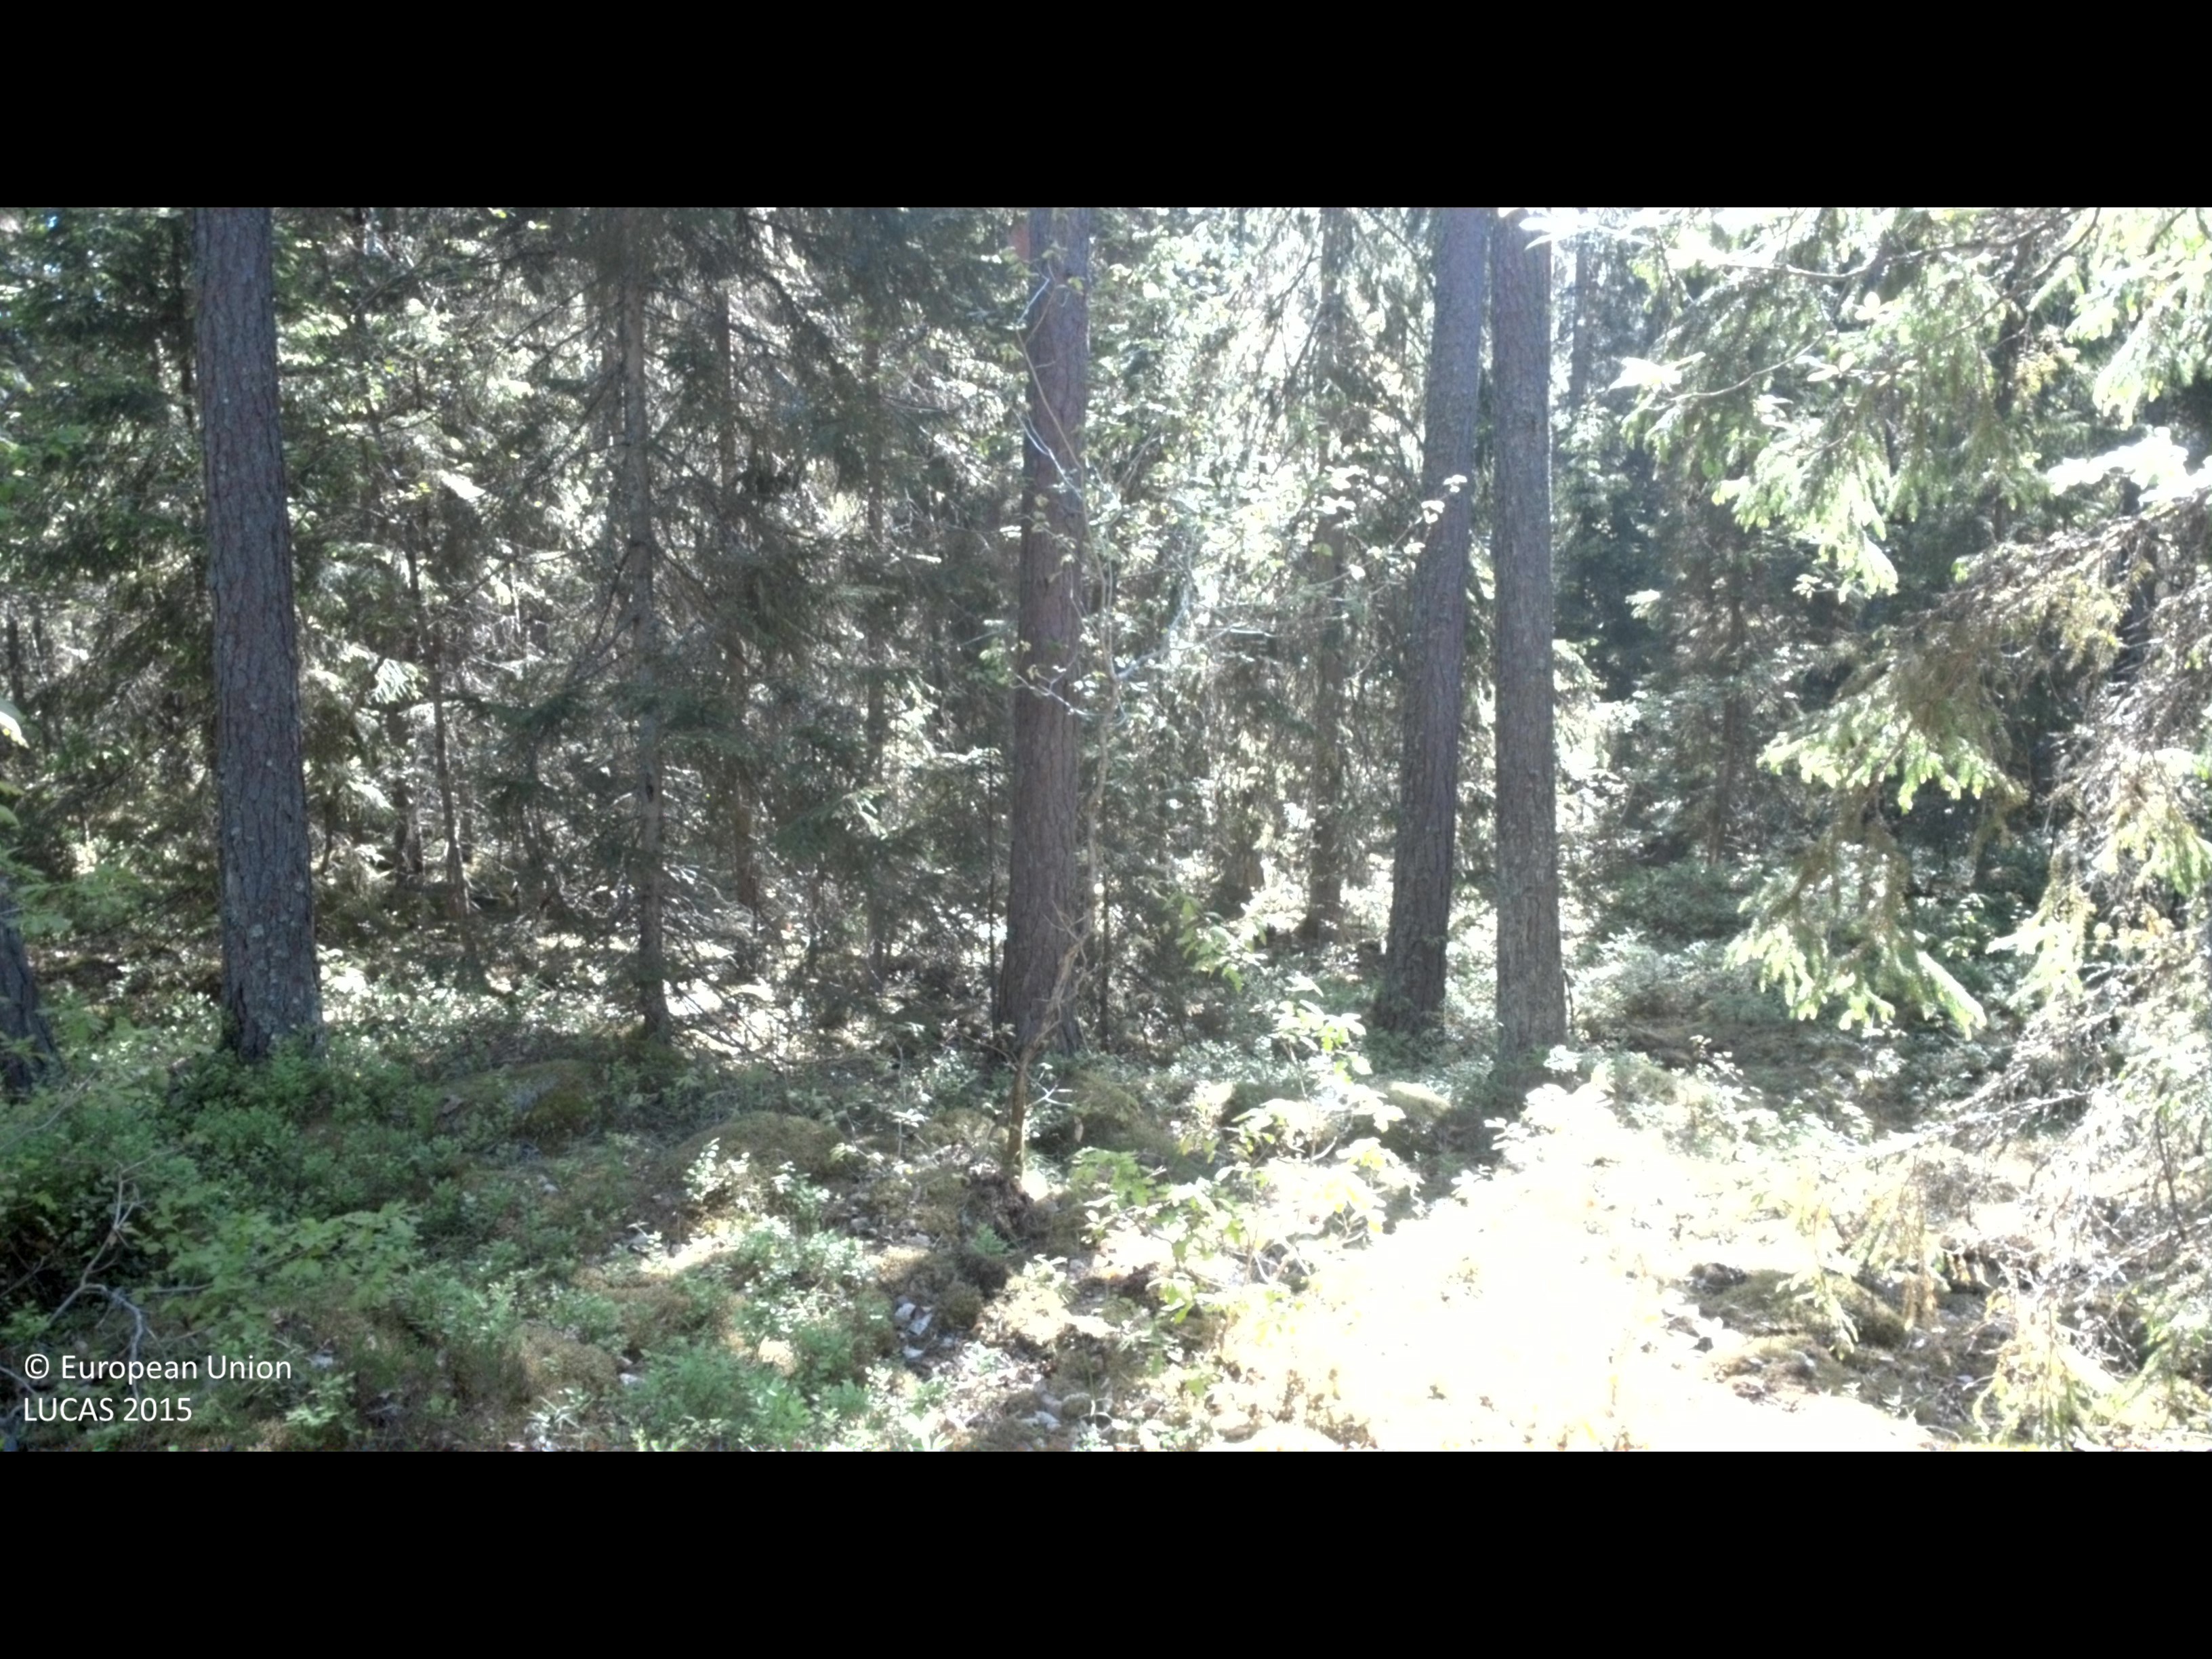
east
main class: Woodland
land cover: Pine dominated coniferous woodland
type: boreal forest
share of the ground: 50 - 75 %
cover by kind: coniferous forest trees 45 %, shrubs 40 %, broadleaved forest trees 5 %, herbaceous plants 5 %, lichens and mosses 5 %
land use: Forestry
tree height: > 5 m
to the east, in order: Pine dominated coniferous woodland; Spruce dominated coniferous woodland; Tracks; Pine dominated mixed woodland; Pine dominated coniferous woodland; Spruce dominated coniferous woodland; Pine dominated coniferous woodland; Shrubland with sparse tree cover
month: May
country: SE
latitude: 57.3680
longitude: 16.3007
